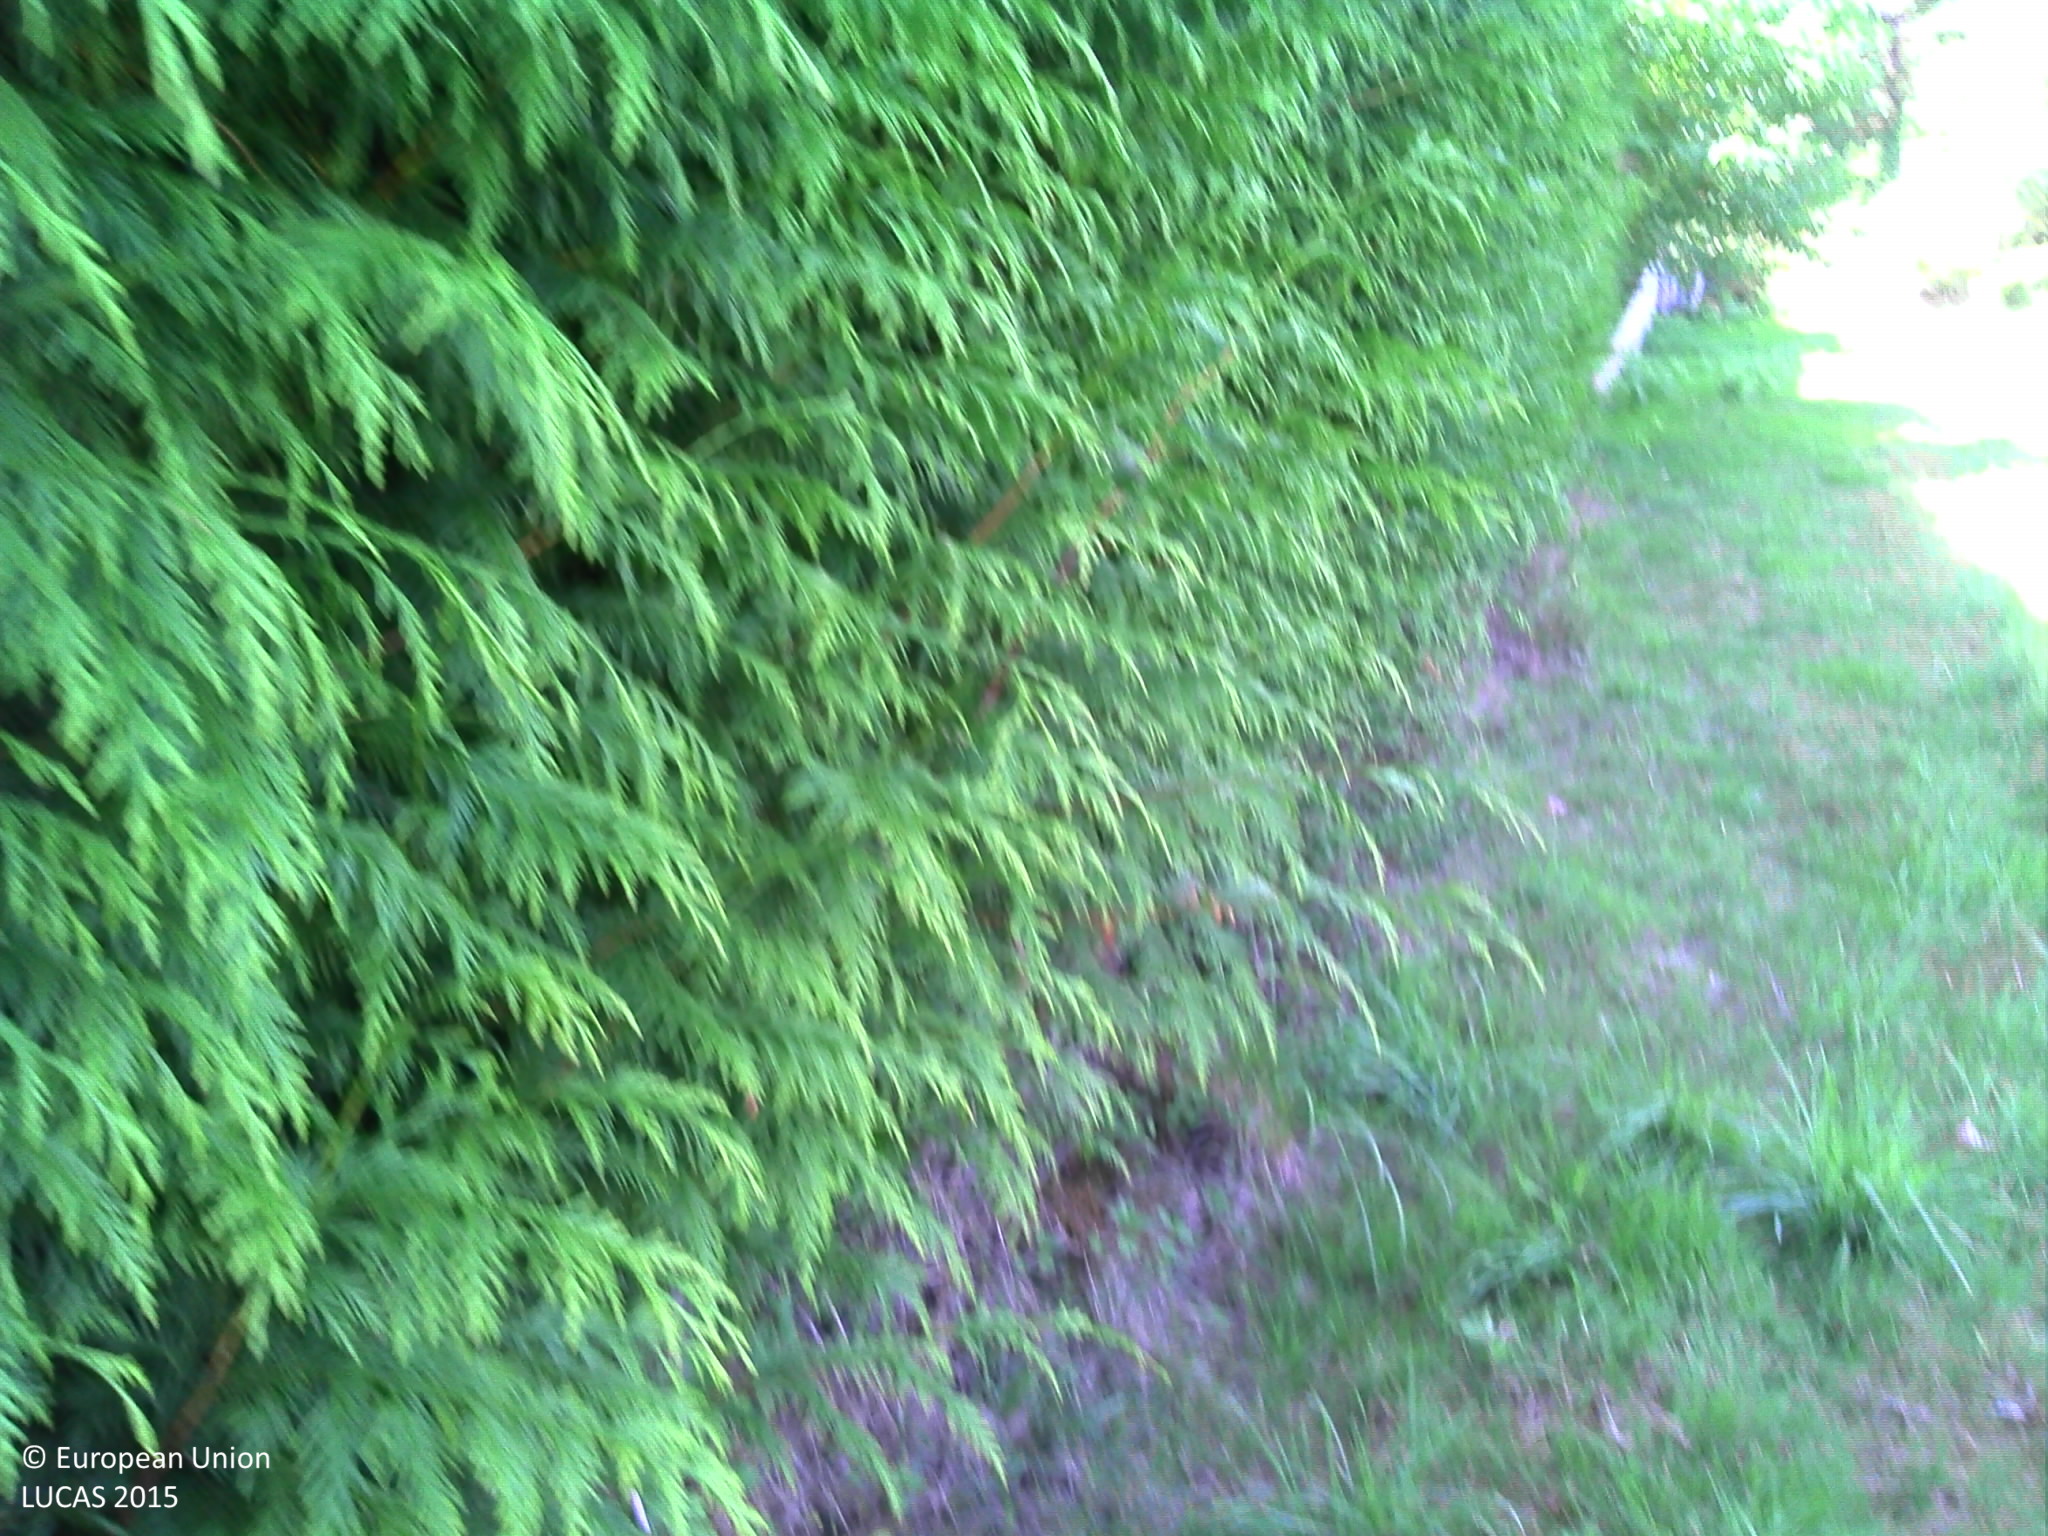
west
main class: Grassland
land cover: Grassland without tree/shrub cover
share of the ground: > 75 %
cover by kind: herbaceous plants 100 %
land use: Agriculture (excluding fallow land and kitchen gardens)
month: August
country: FR
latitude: 45.9331
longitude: 1.4149
